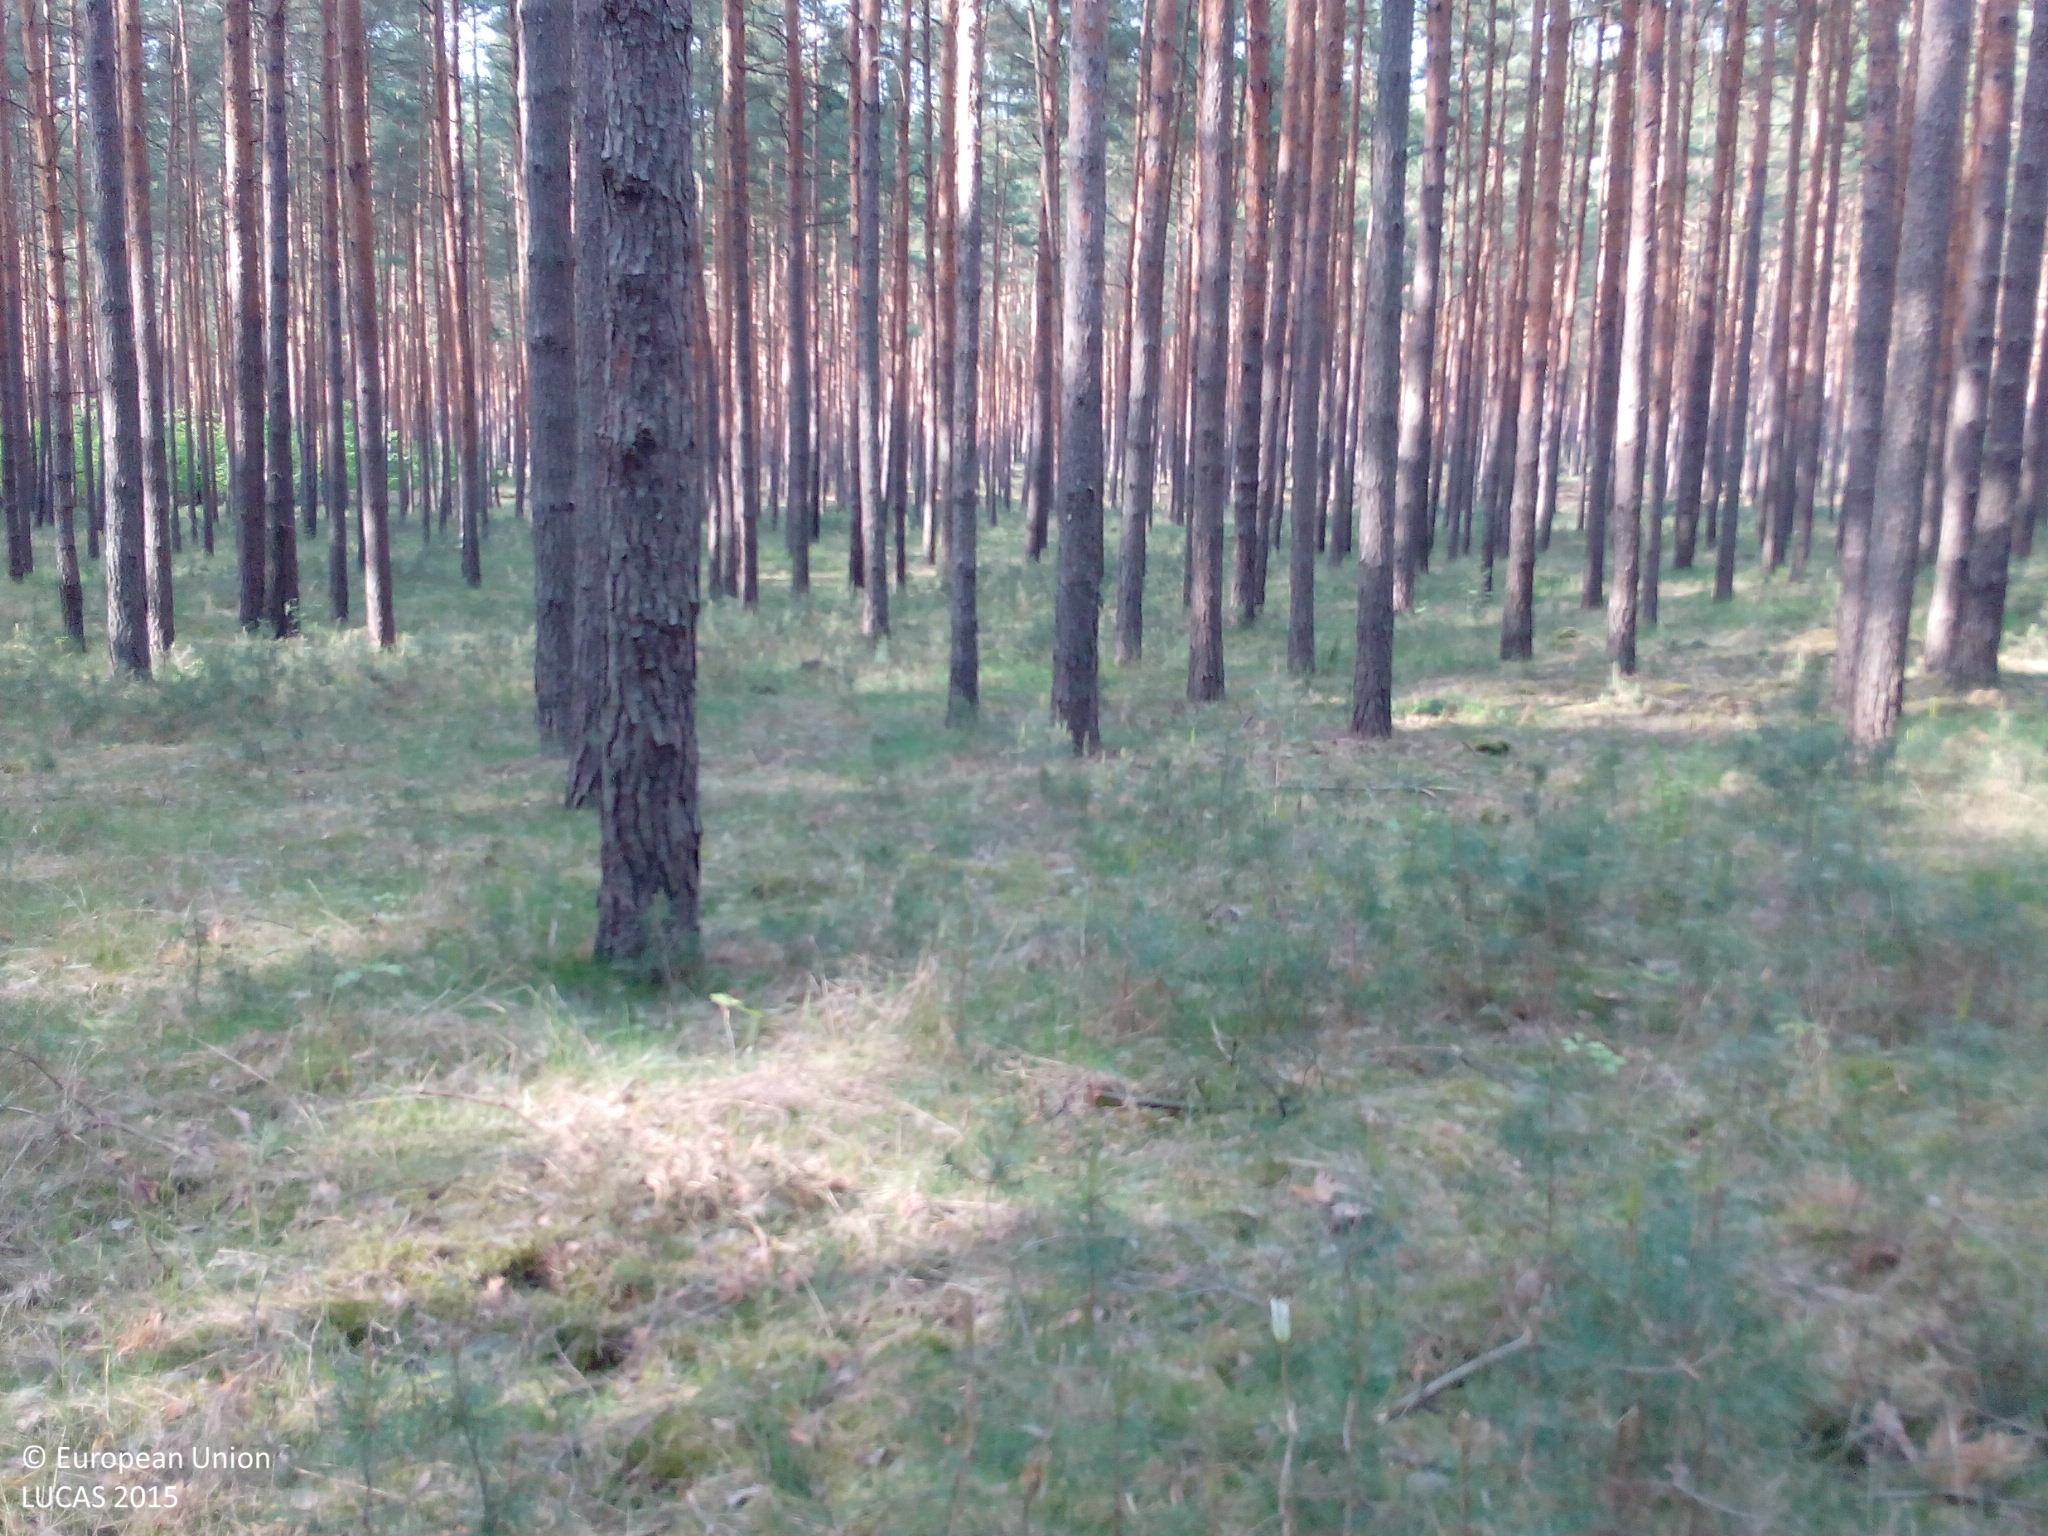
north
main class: Woodland
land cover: Pine dominated coniferous woodland
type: hemiboreal forest and nemoral coniferous forest and mixed broadleaved-coniferous forest
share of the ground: > 75 %
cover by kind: coniferous forest trees 75 %, herbaceous plants 15 %, lichens and mosses 10 %
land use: Forestry
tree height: > 5 m
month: May
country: DE
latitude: 52.1560
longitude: 13.1426
